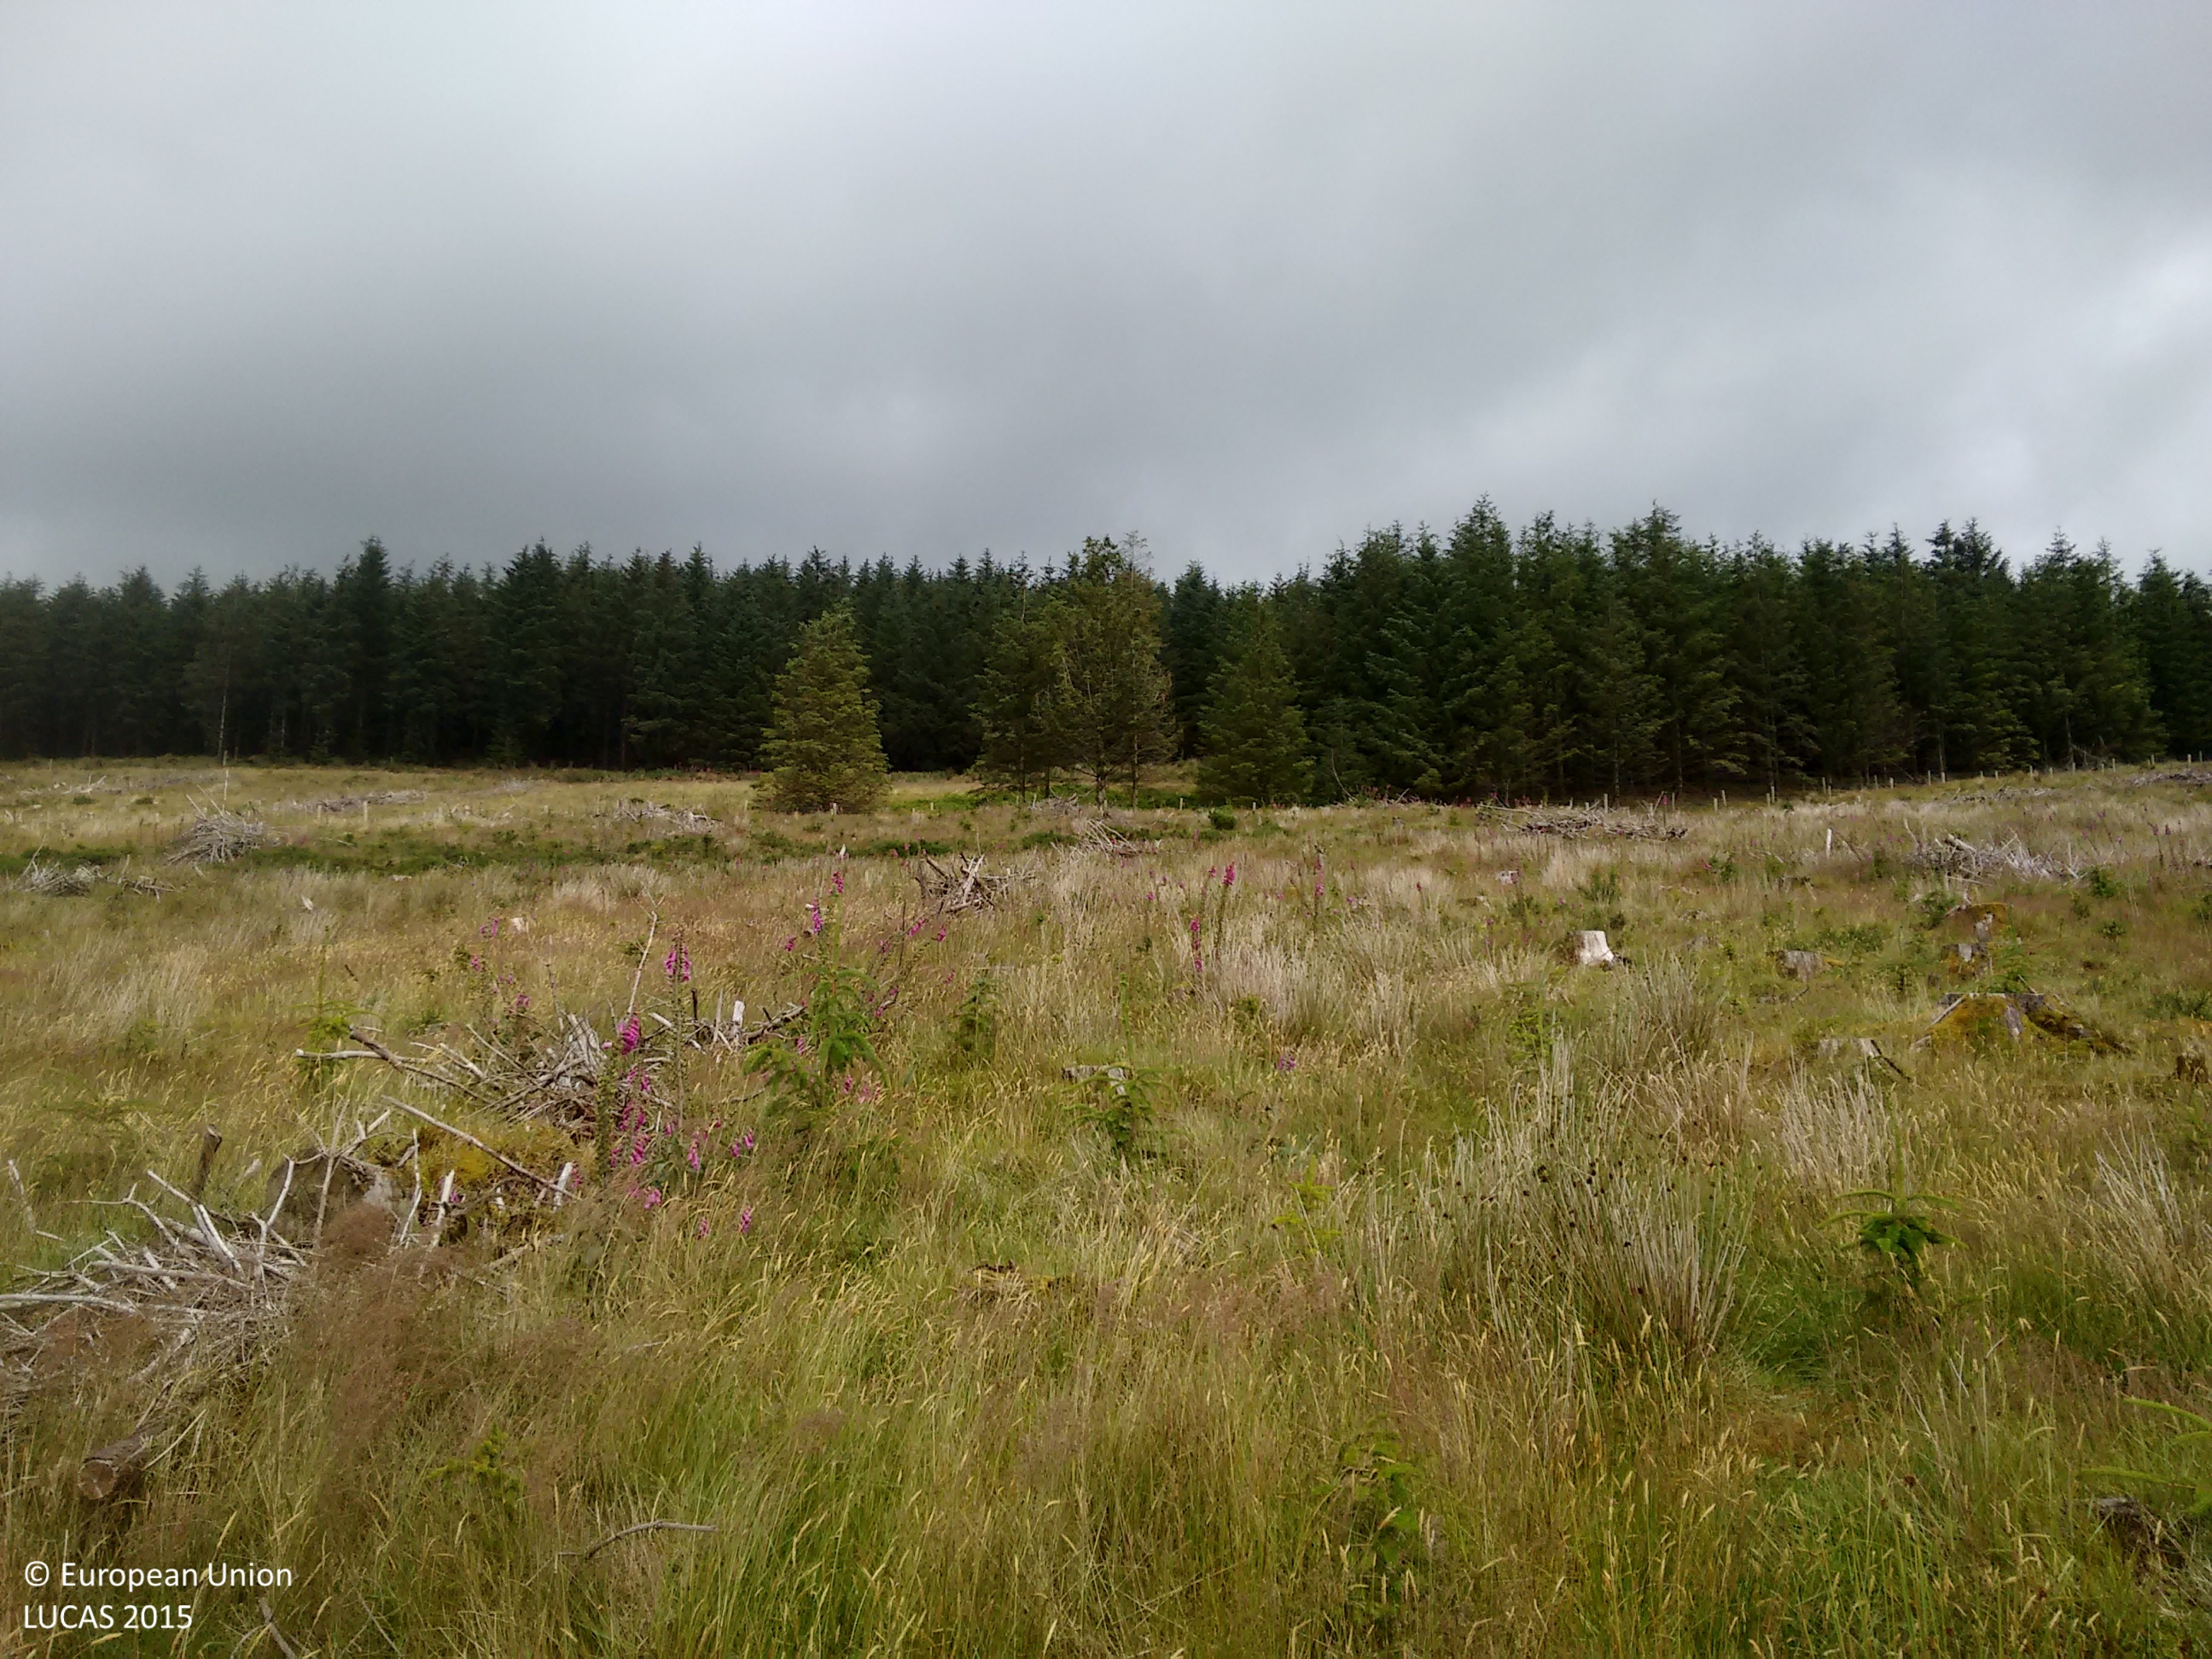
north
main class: Woodland
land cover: Spruce dominated coniferous woodland
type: exotic forest
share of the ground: 10 - 25 %
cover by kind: herbaceous plants 80 %, coniferous forest trees 15 %, shrubs 5 %
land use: Forestry
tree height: < 5 m
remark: Clear cut
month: July
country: IE
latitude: 53.0202
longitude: -6.5725
